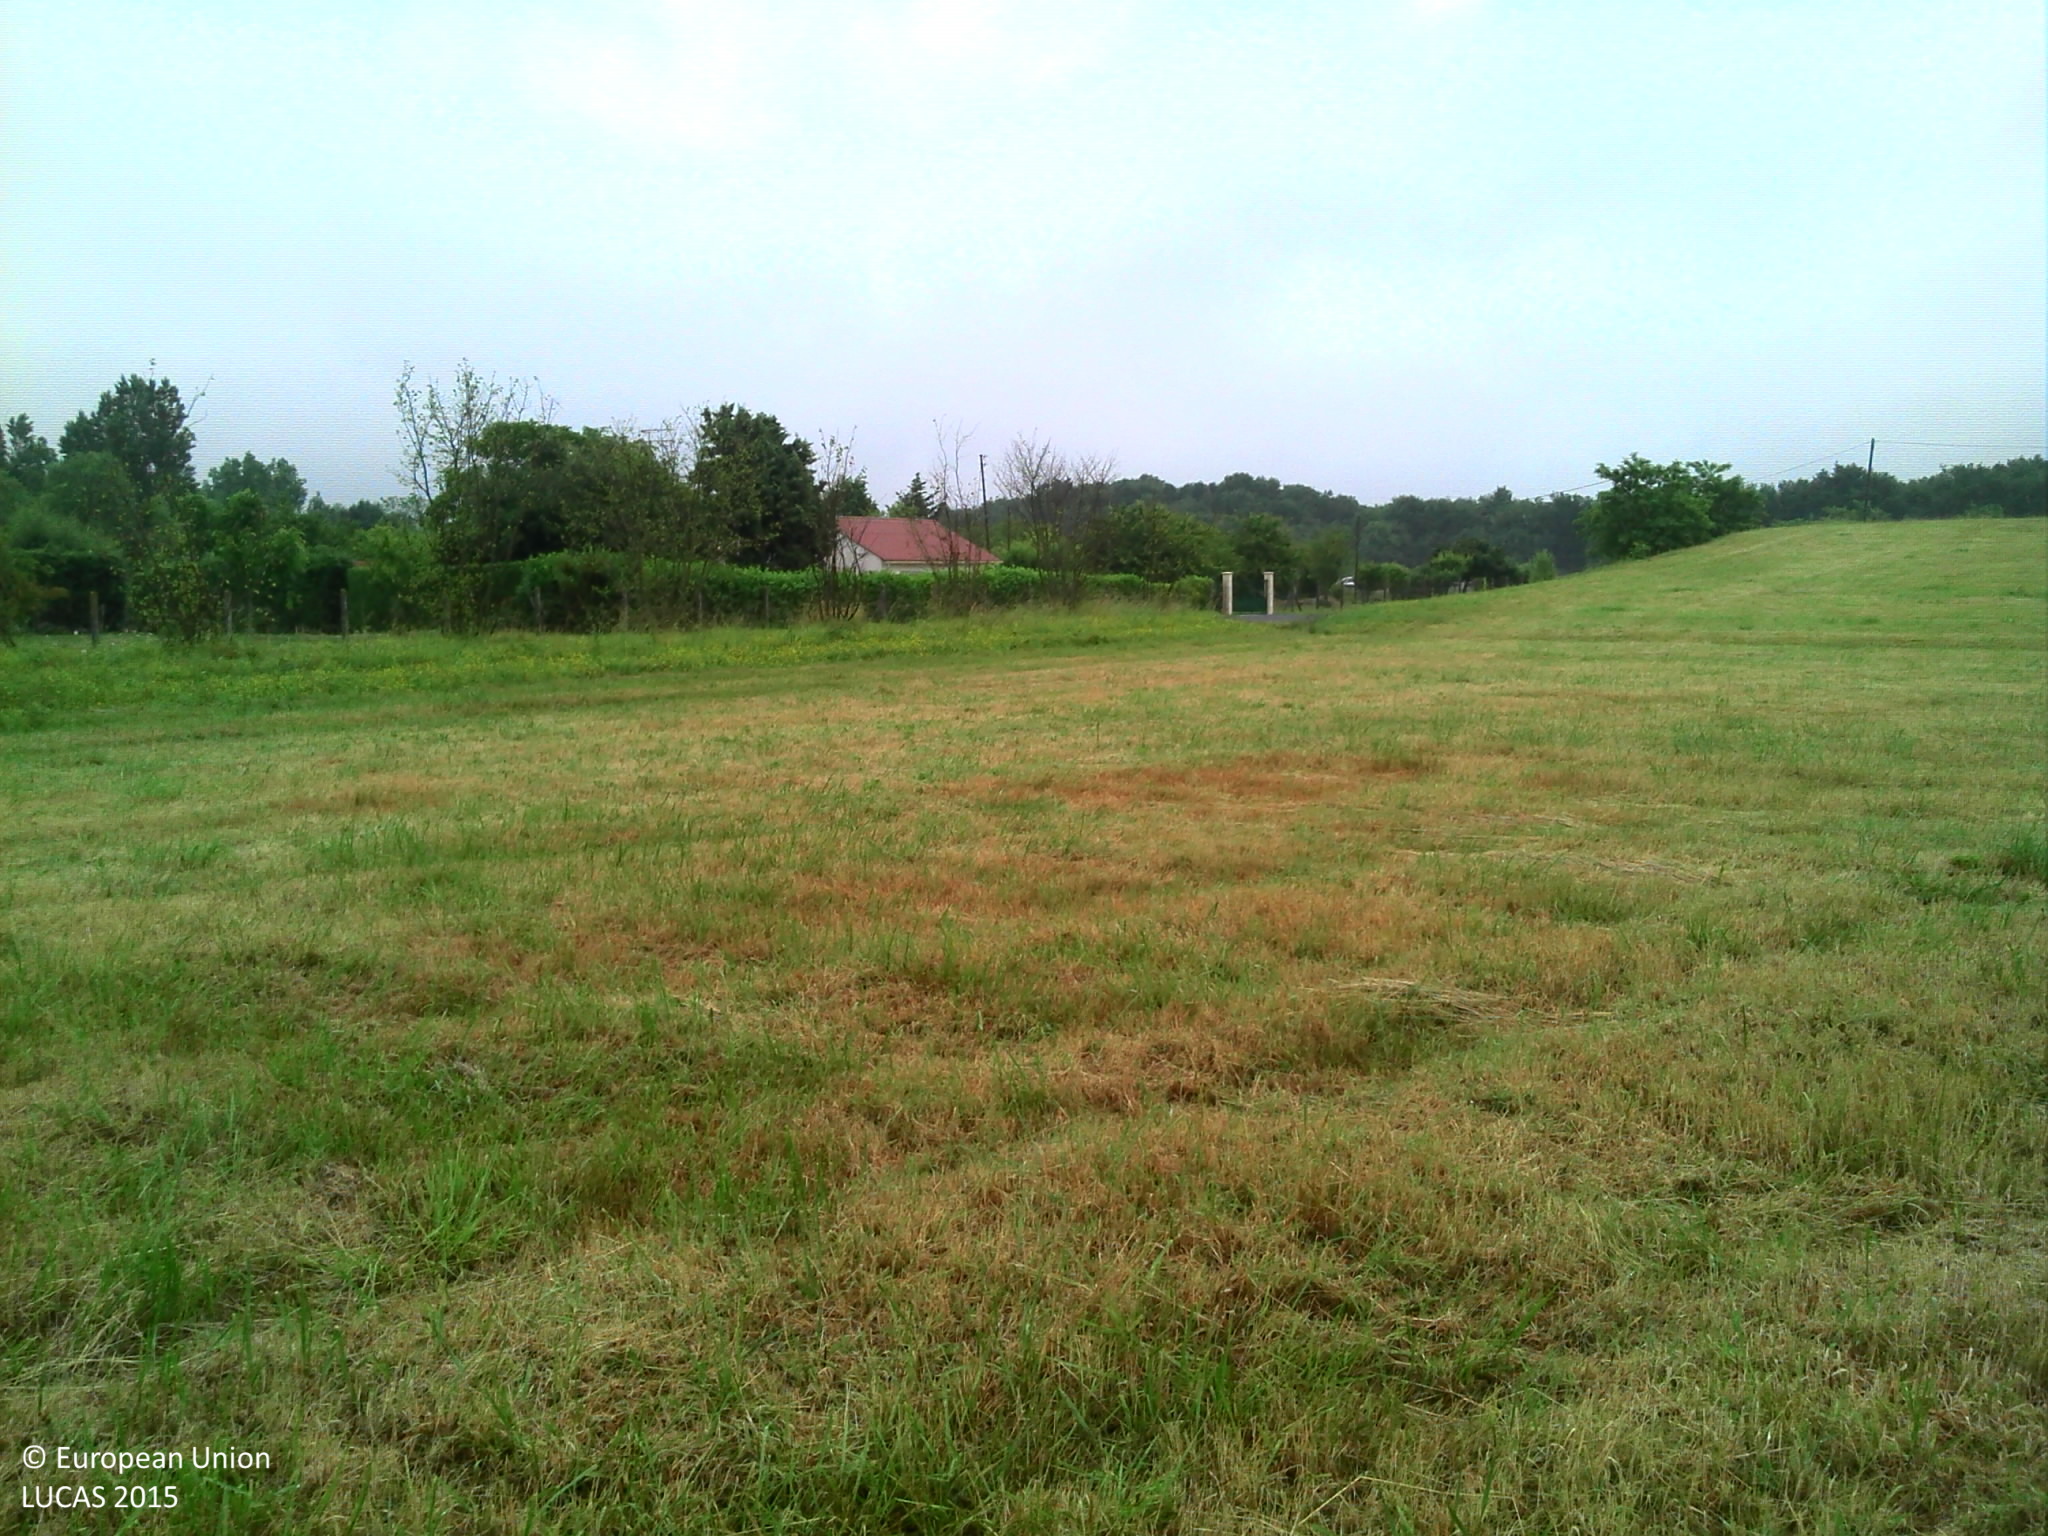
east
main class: Grassland
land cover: Grassland without tree/shrub cover
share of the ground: > 75 %
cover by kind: herbaceous plants 100 %
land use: Agriculture (excluding fallow land and kitchen gardens)
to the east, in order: Grassland without tree/shrub cover; Abandoned hedges; Grass margins; Ditches and canals; Grass margins; Artificial constructions in urban areas; Fences; Grassland without tree/shrub cover; Electric lines; Paved roads, cycling and walking lanes; Fences; Grass margins; Shrubland without tree cover
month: June
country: FR
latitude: 46.5433
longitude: 0.2915
